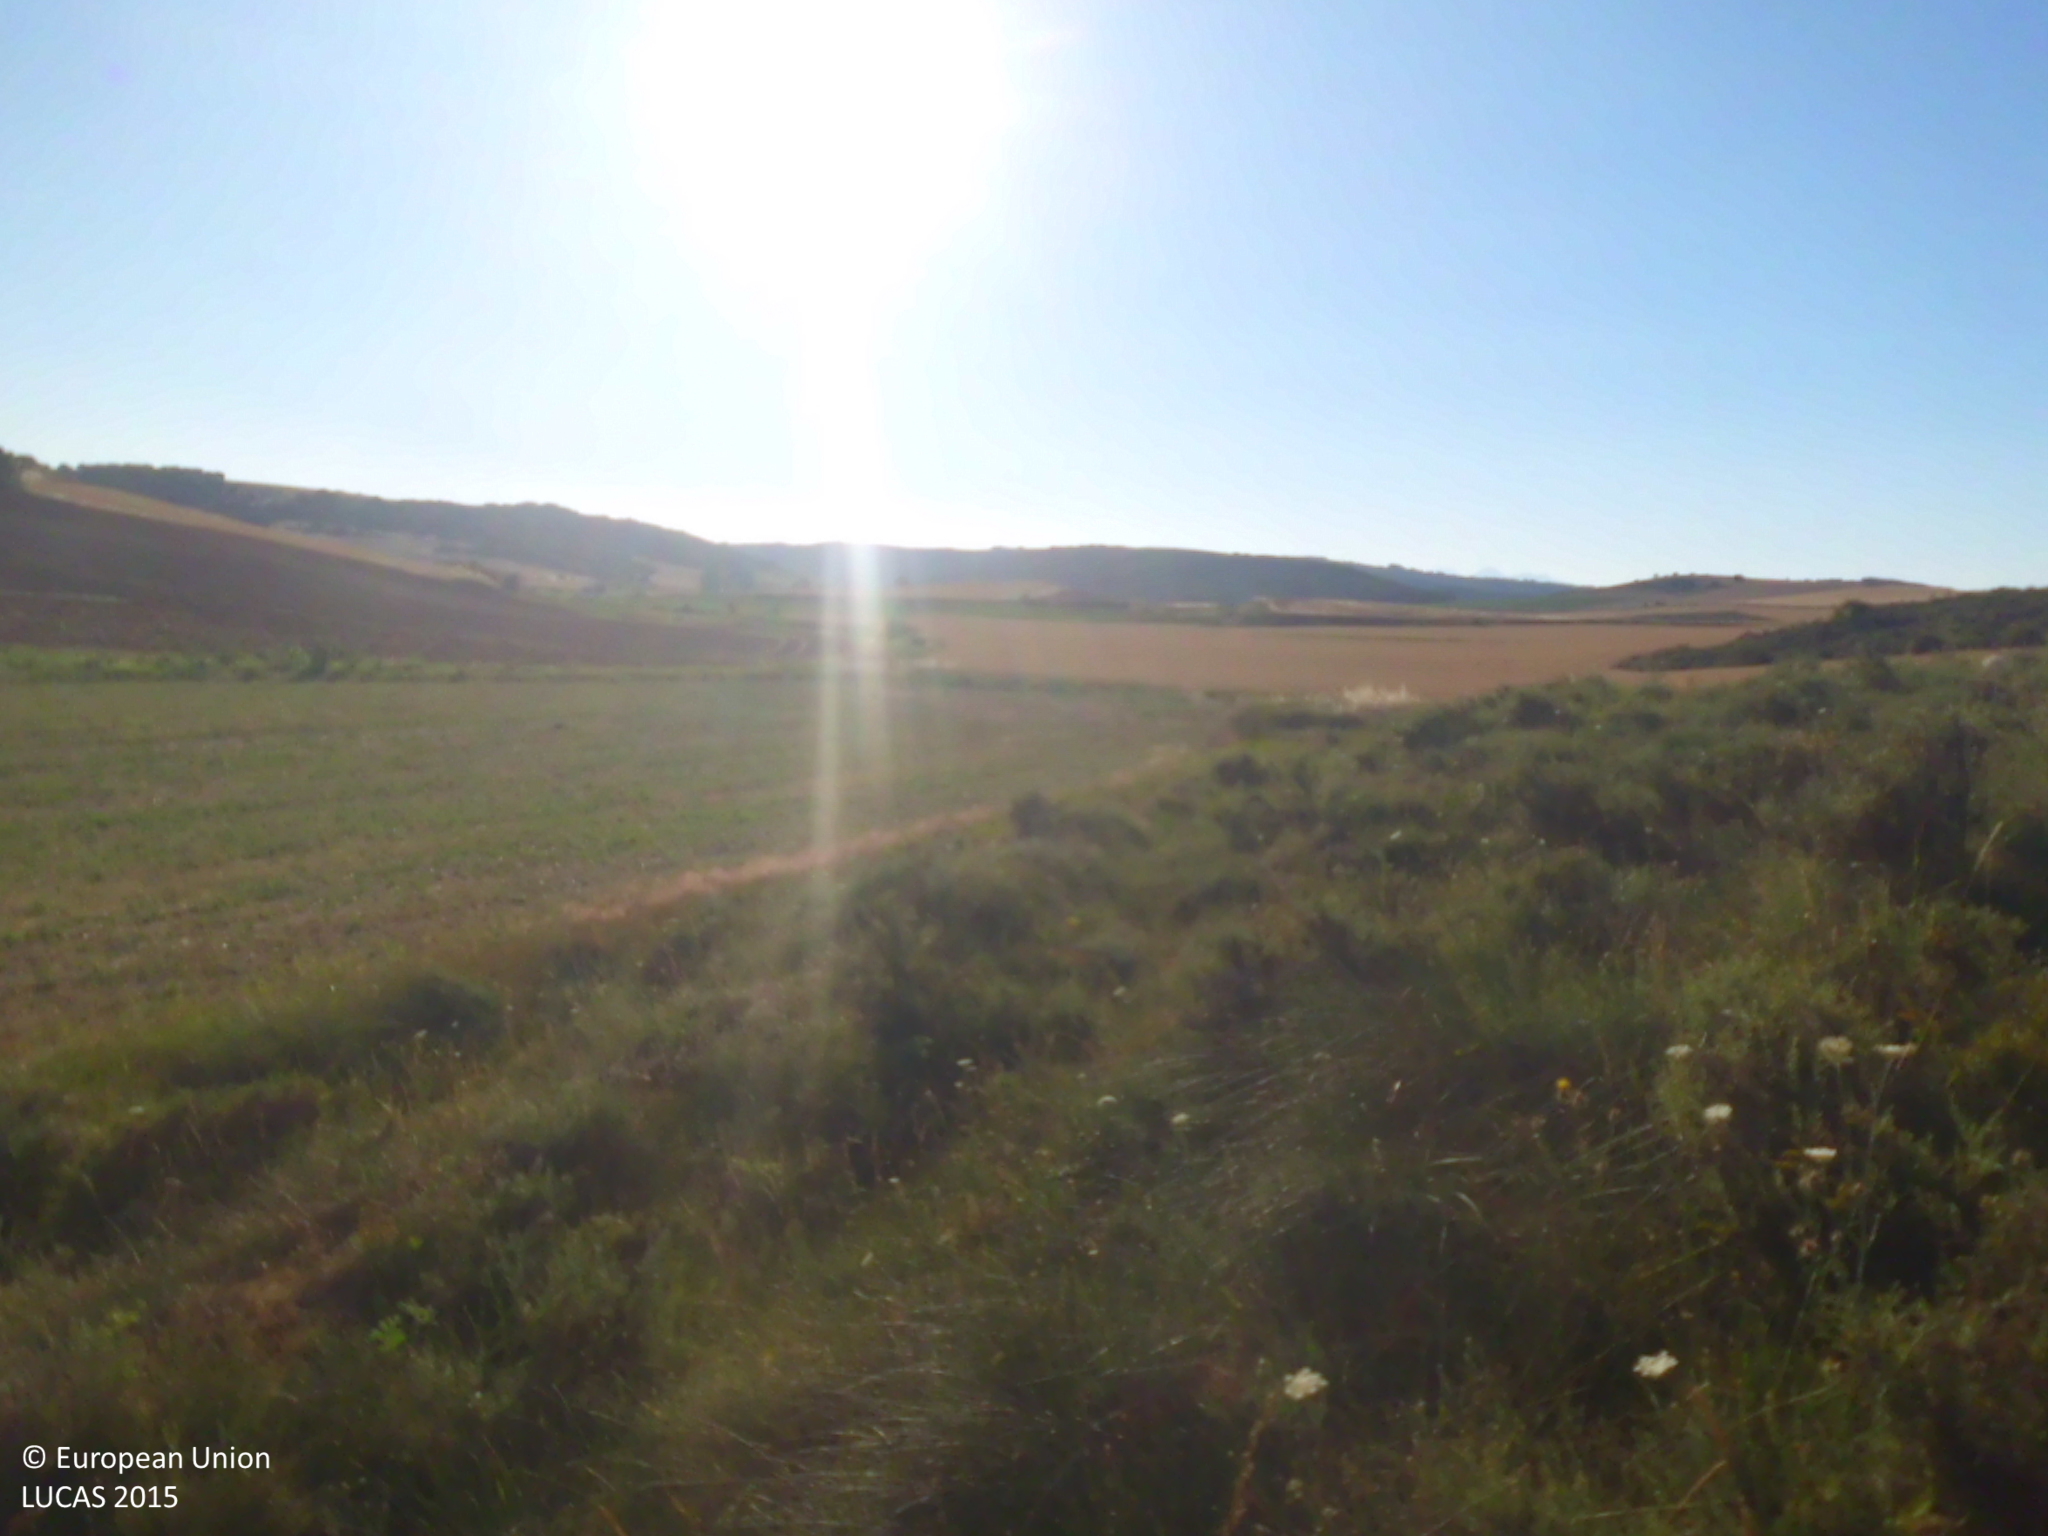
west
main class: Shrubland
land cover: Shrubland without tree cover
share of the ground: 50 - 75 %
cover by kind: shrubs 60 %, herbaceous plants 30 %, consolidated bare surface 10 %
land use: Semi-natural and natural areas not in use
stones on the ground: 25 - 50 %
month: July
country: ES
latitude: 42.6287
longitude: -4.2537
